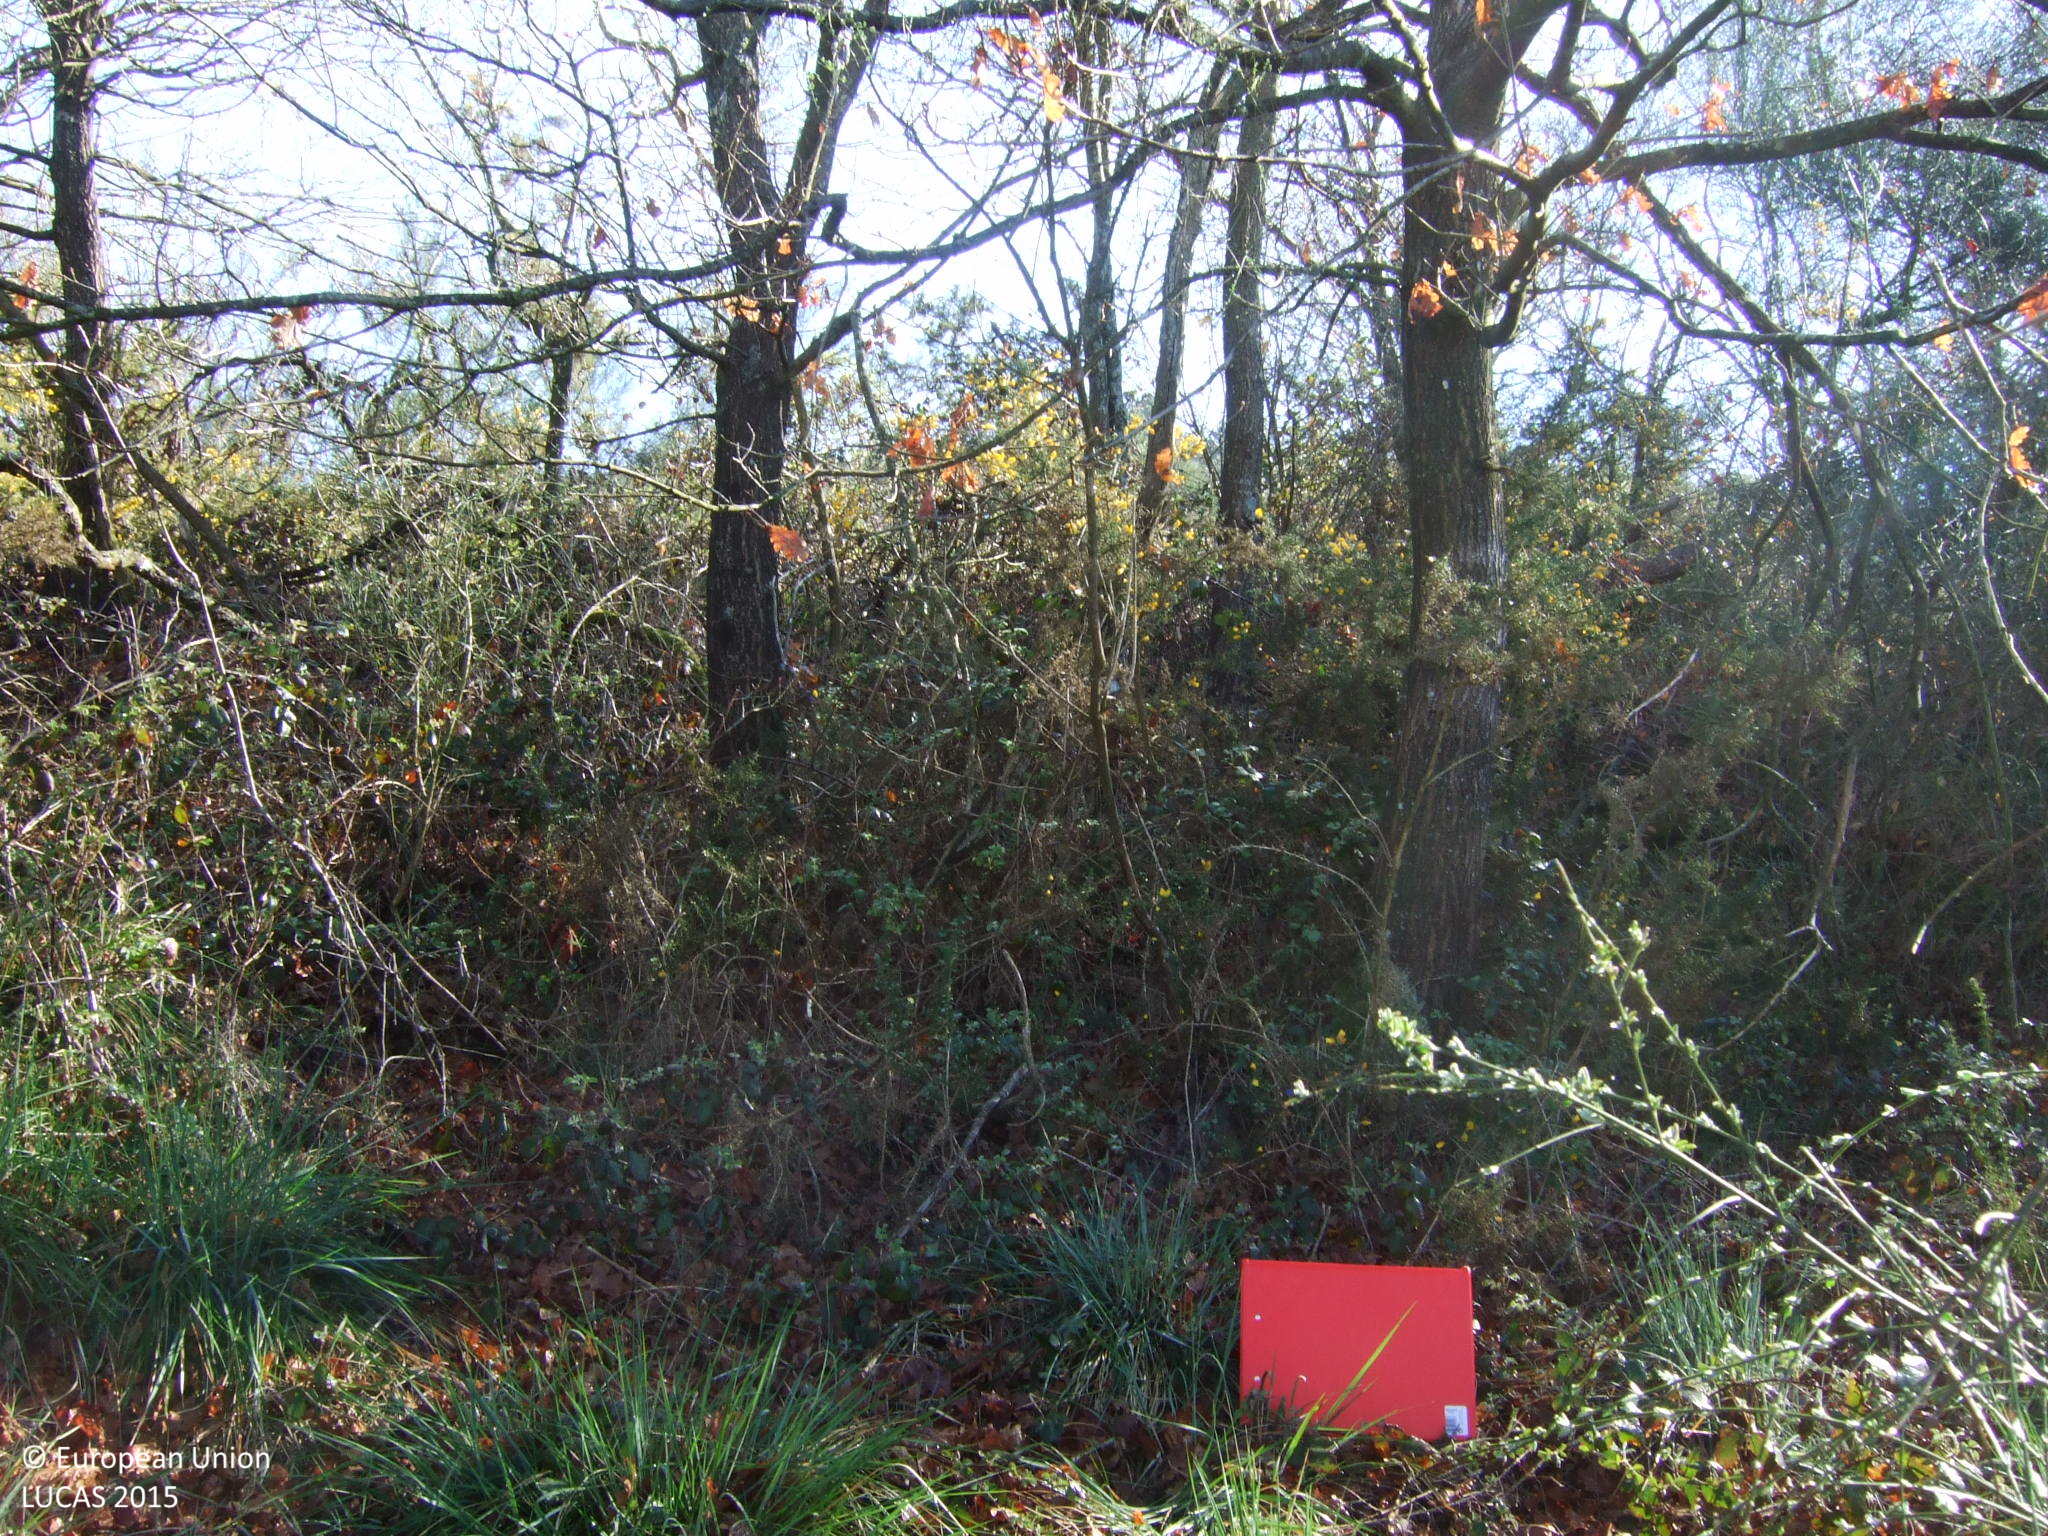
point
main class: Woodland
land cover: Broadleaved woodland
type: acidophilous oak and oak-birch forest
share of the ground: 10 - 25 %
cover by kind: shrubs 50 %, herbaceous plants 30 %, broadleaved forest trees 20 %
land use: Semi-natural and natural areas not in use
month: April
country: ES
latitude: 42.7617
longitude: -7.7868
